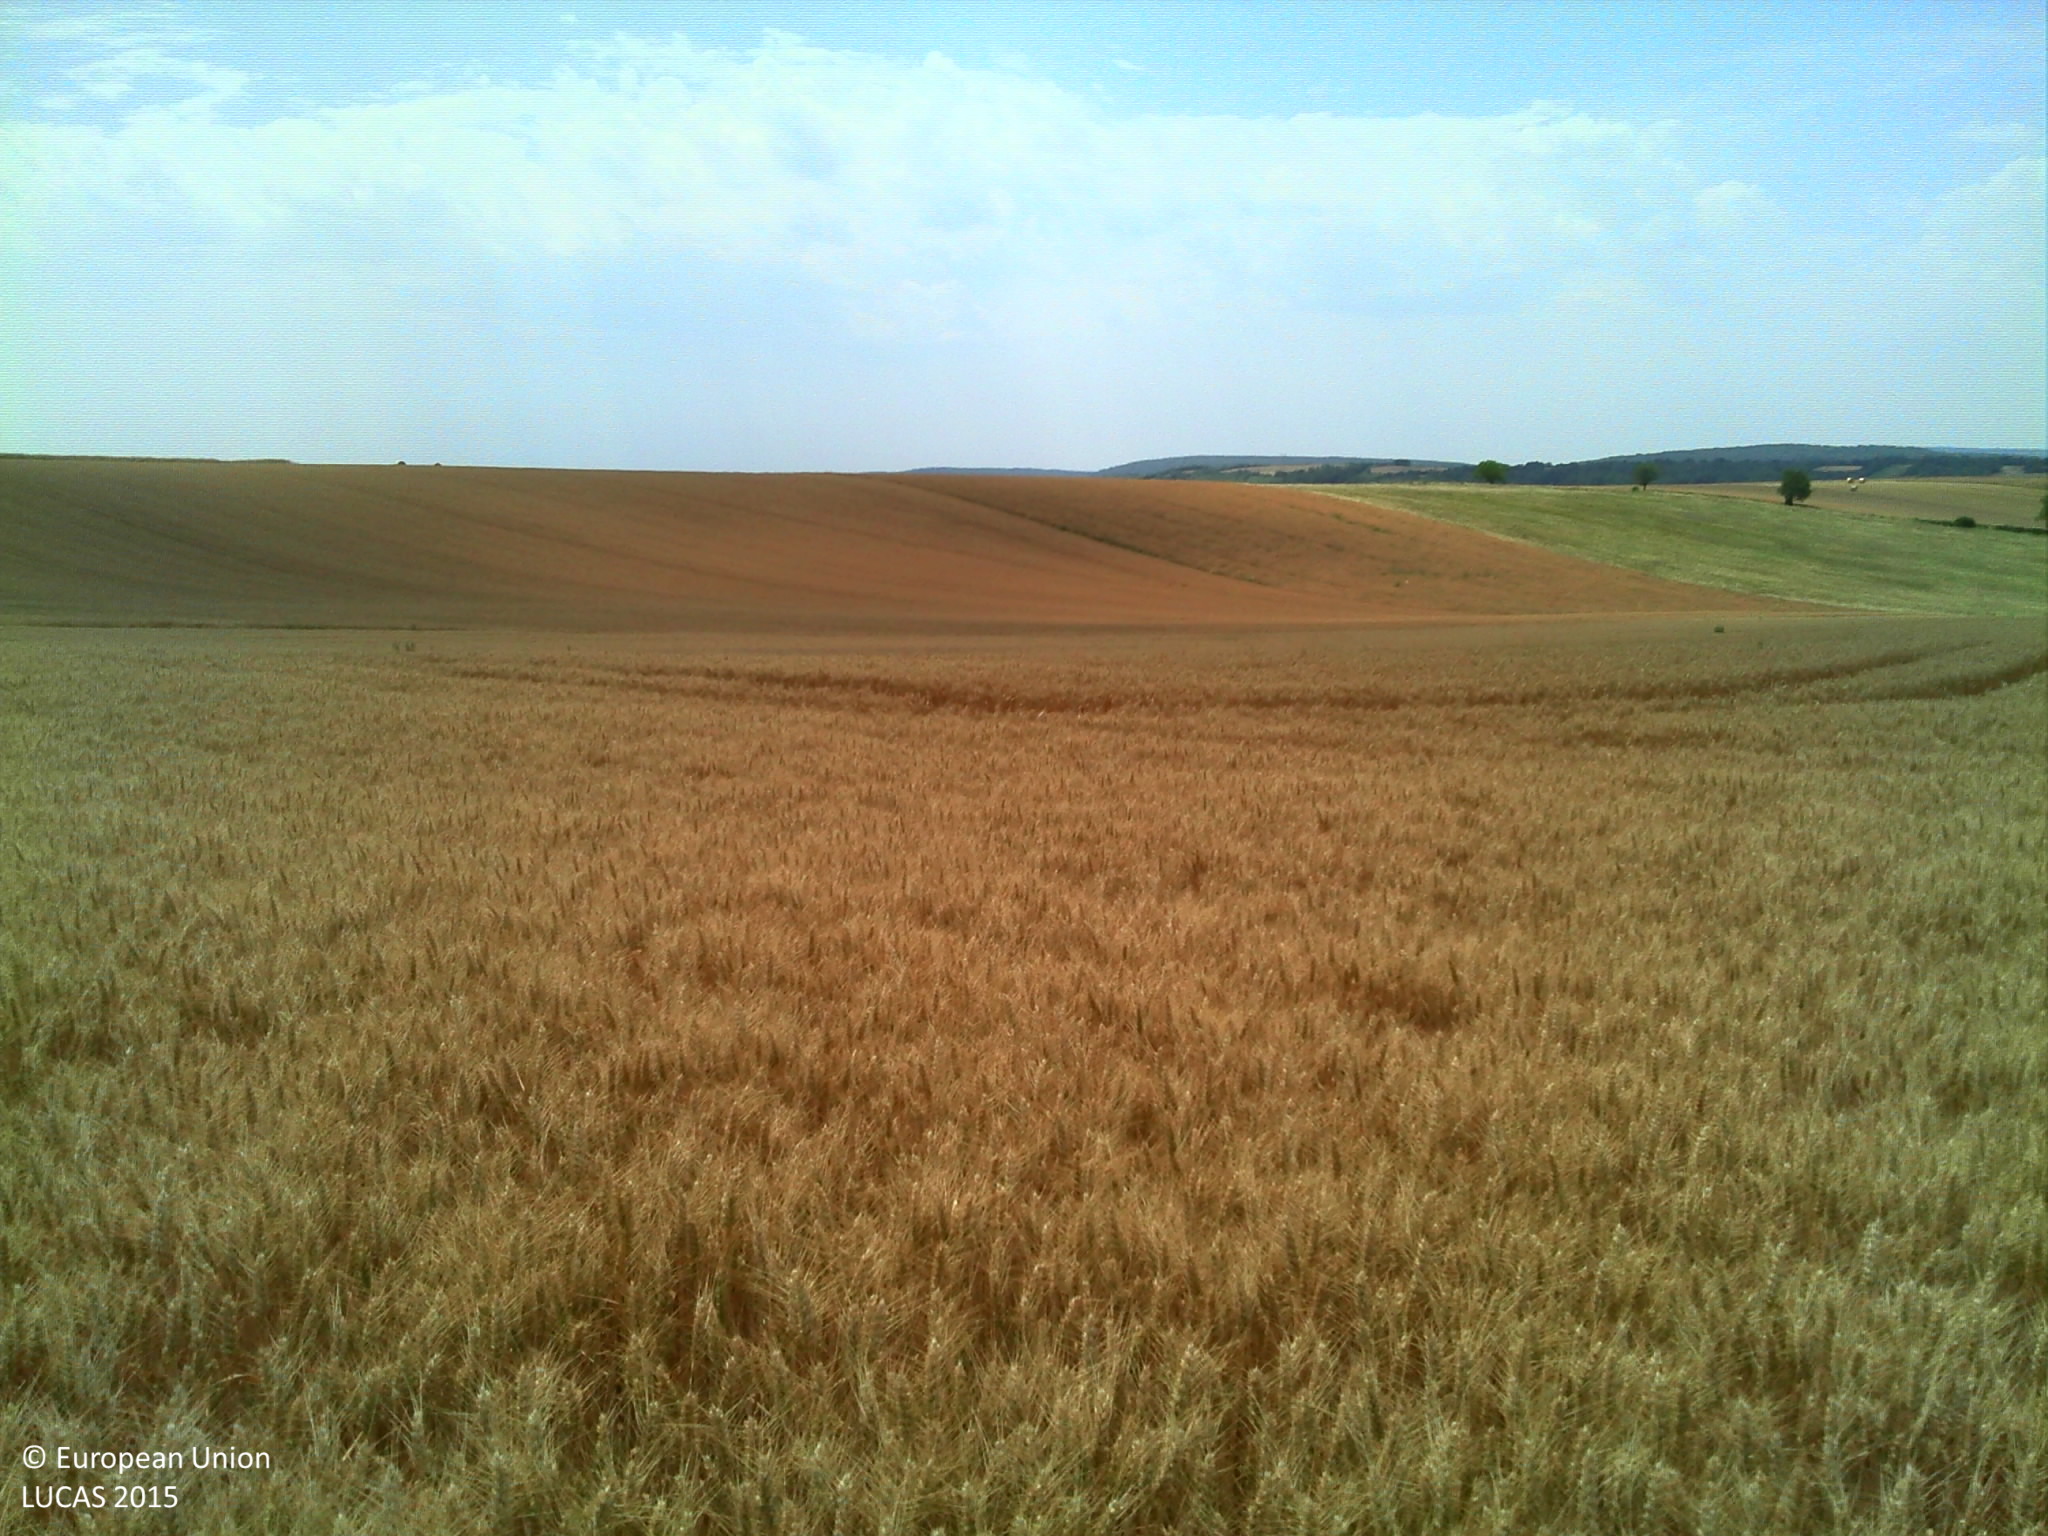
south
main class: Cropland
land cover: Durum wheat
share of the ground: > 75 %
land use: Agriculture (excluding fallow land and kitchen gardens)
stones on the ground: 10 - 25 %
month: July
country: FR
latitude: 47.2932
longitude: 3.5305
